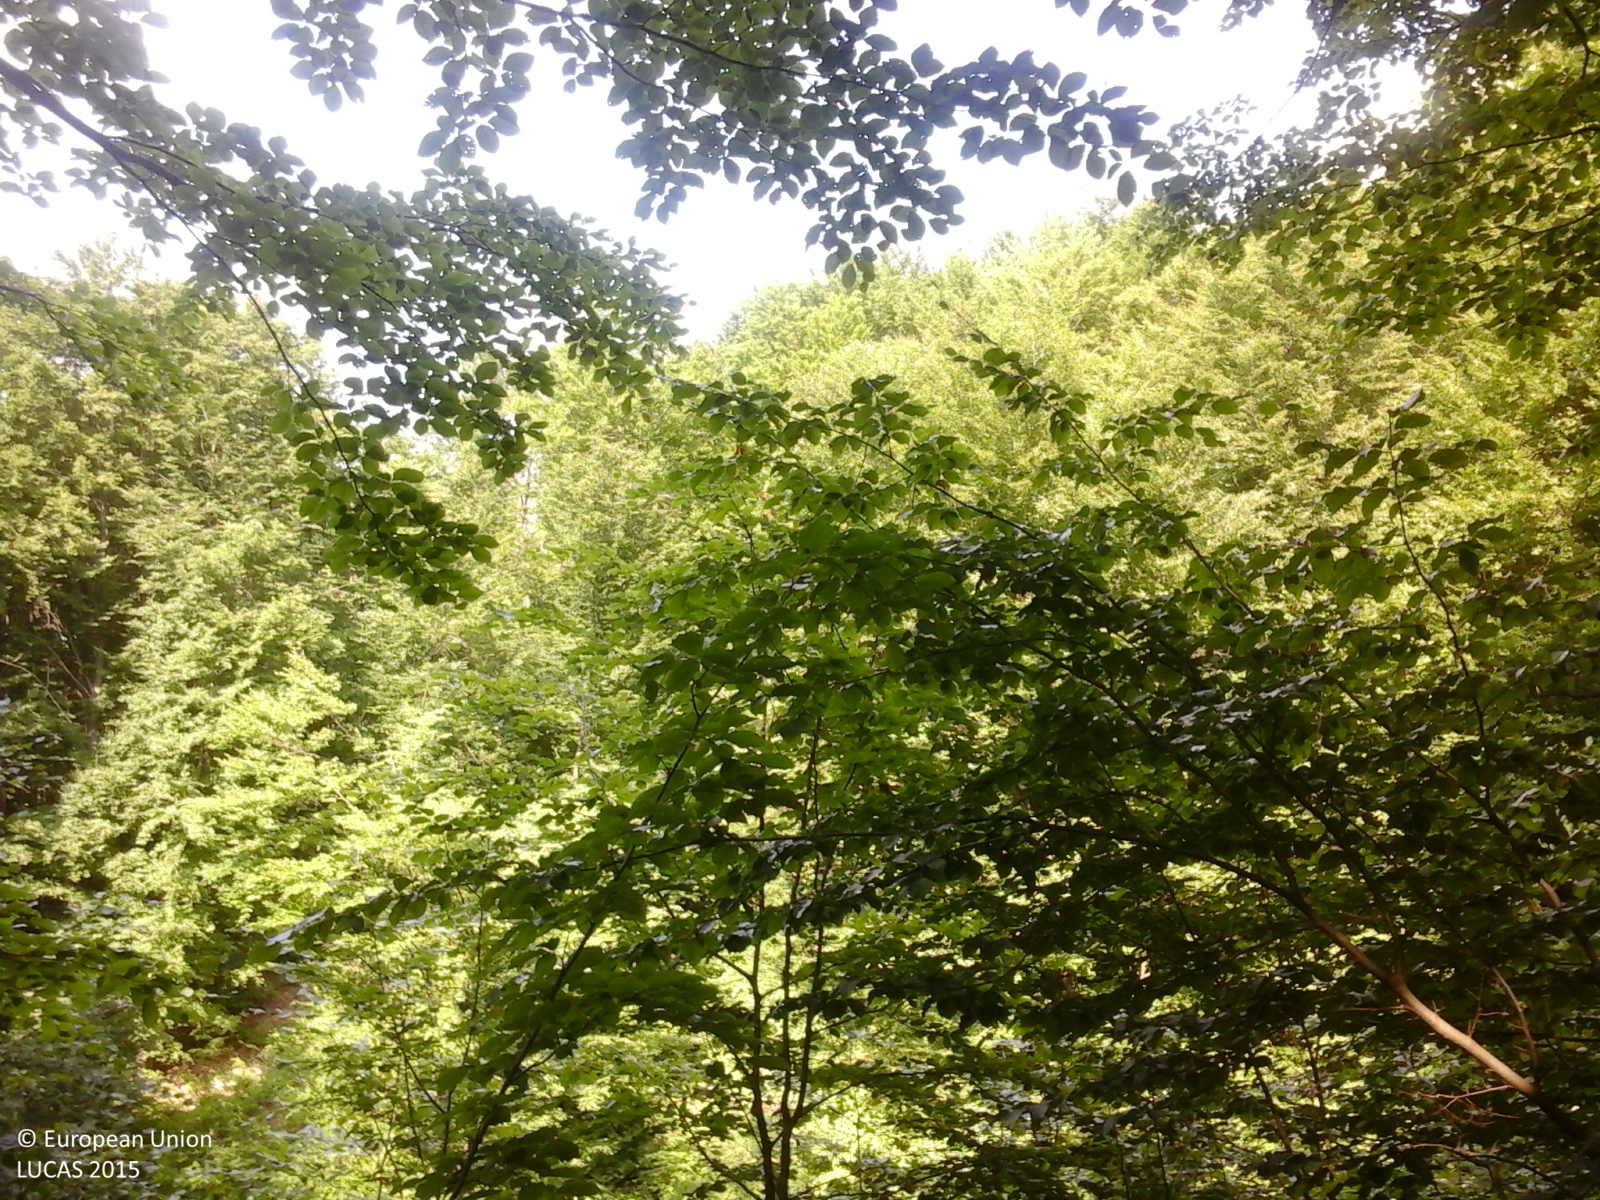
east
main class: Woodland
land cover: Broadleaved woodland
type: beech forest
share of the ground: > 75 %
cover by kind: broadleaved forest trees 100 %
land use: Forestry
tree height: > 5 m
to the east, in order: Broadleaved woodland; Other fruit trees and berries; Broadleaved woodland
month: June
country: RO
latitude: 46.4656
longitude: 26.6633
